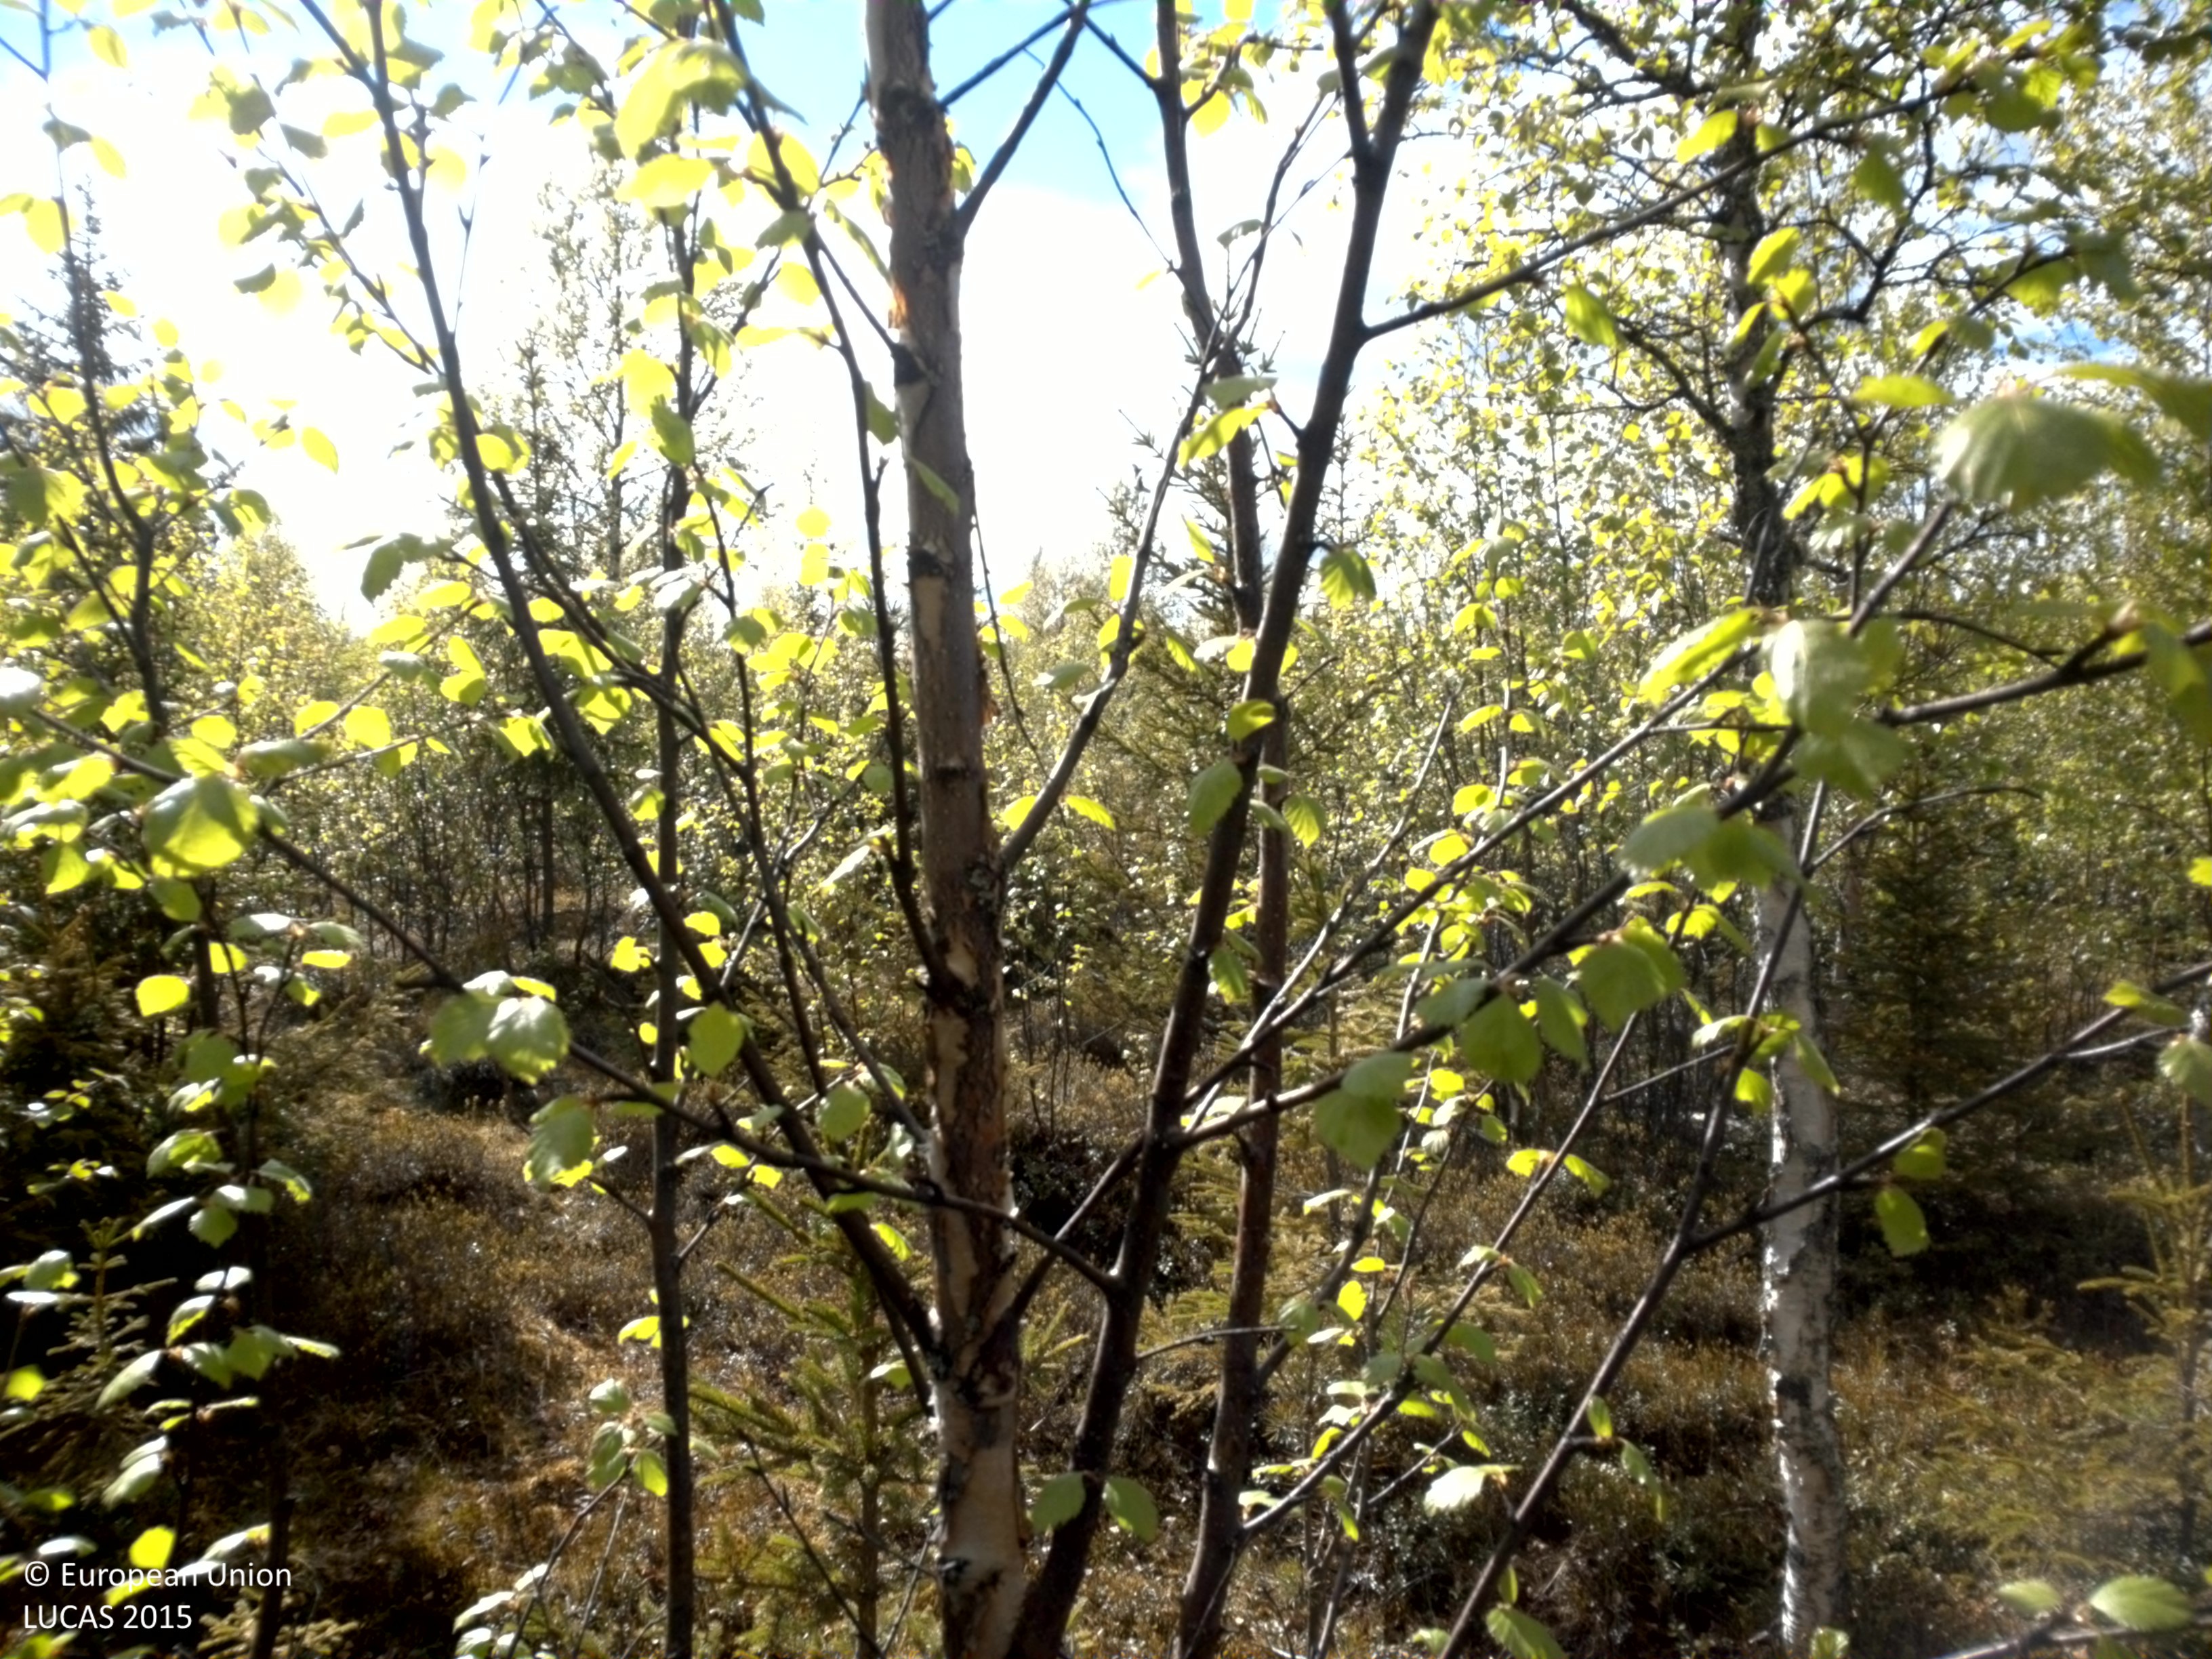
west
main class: Woodland
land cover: Broadleaved woodland
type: boreal forest
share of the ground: 50 - 75 %
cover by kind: broadleaved forest trees 65 %, herbaceous plants 15 %, coniferous forest trees 10 %, lichens and mosses 10 %
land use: Forestry
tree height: < 5 m
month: June
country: SE
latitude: 64.4081
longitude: 17.3752
